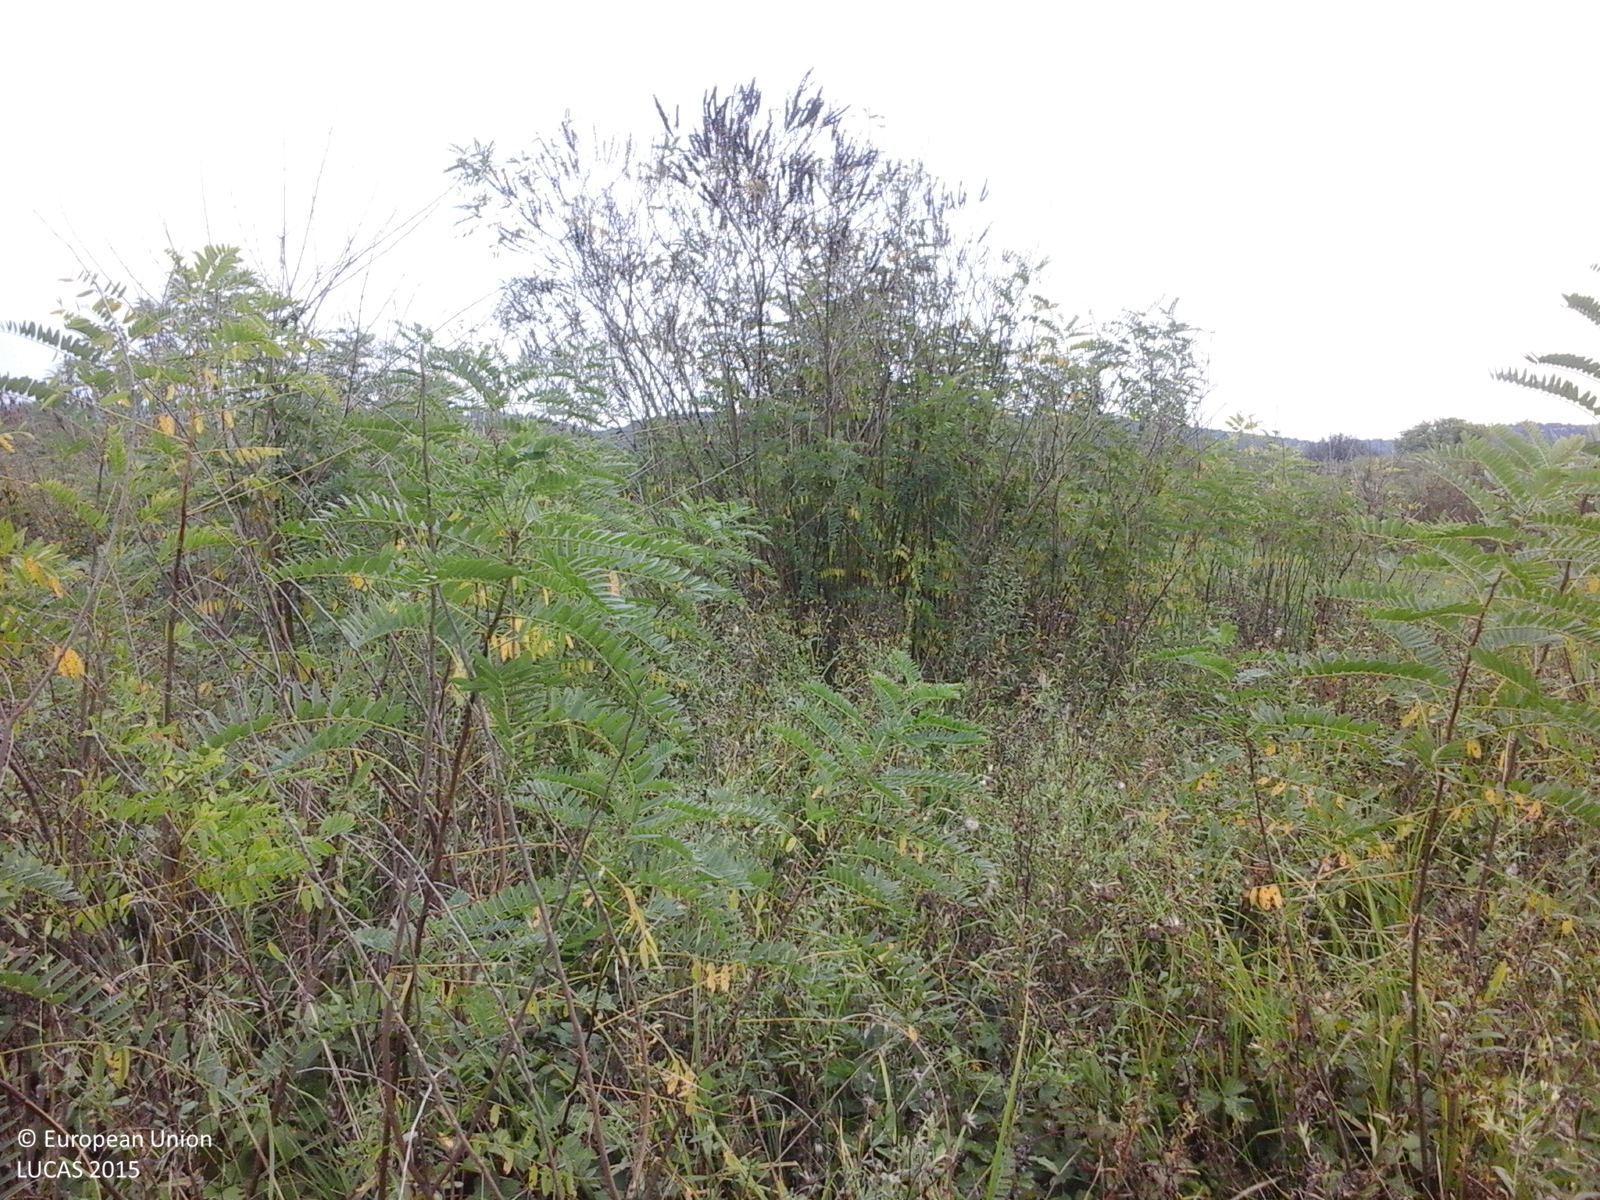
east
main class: Grassland
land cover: Spontaneously vegetated surfaces
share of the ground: > 75 %
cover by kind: herbaceous plants 100 %
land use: Fallow land
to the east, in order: Spontaneously vegetated surfaces; Grassland without tree/shrub cover; Abandoned hedges; Ditches and canals; Abandoned hedges; Grassland without tree/shrub cover
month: September
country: RO
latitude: 45.9936
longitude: 22.2195
